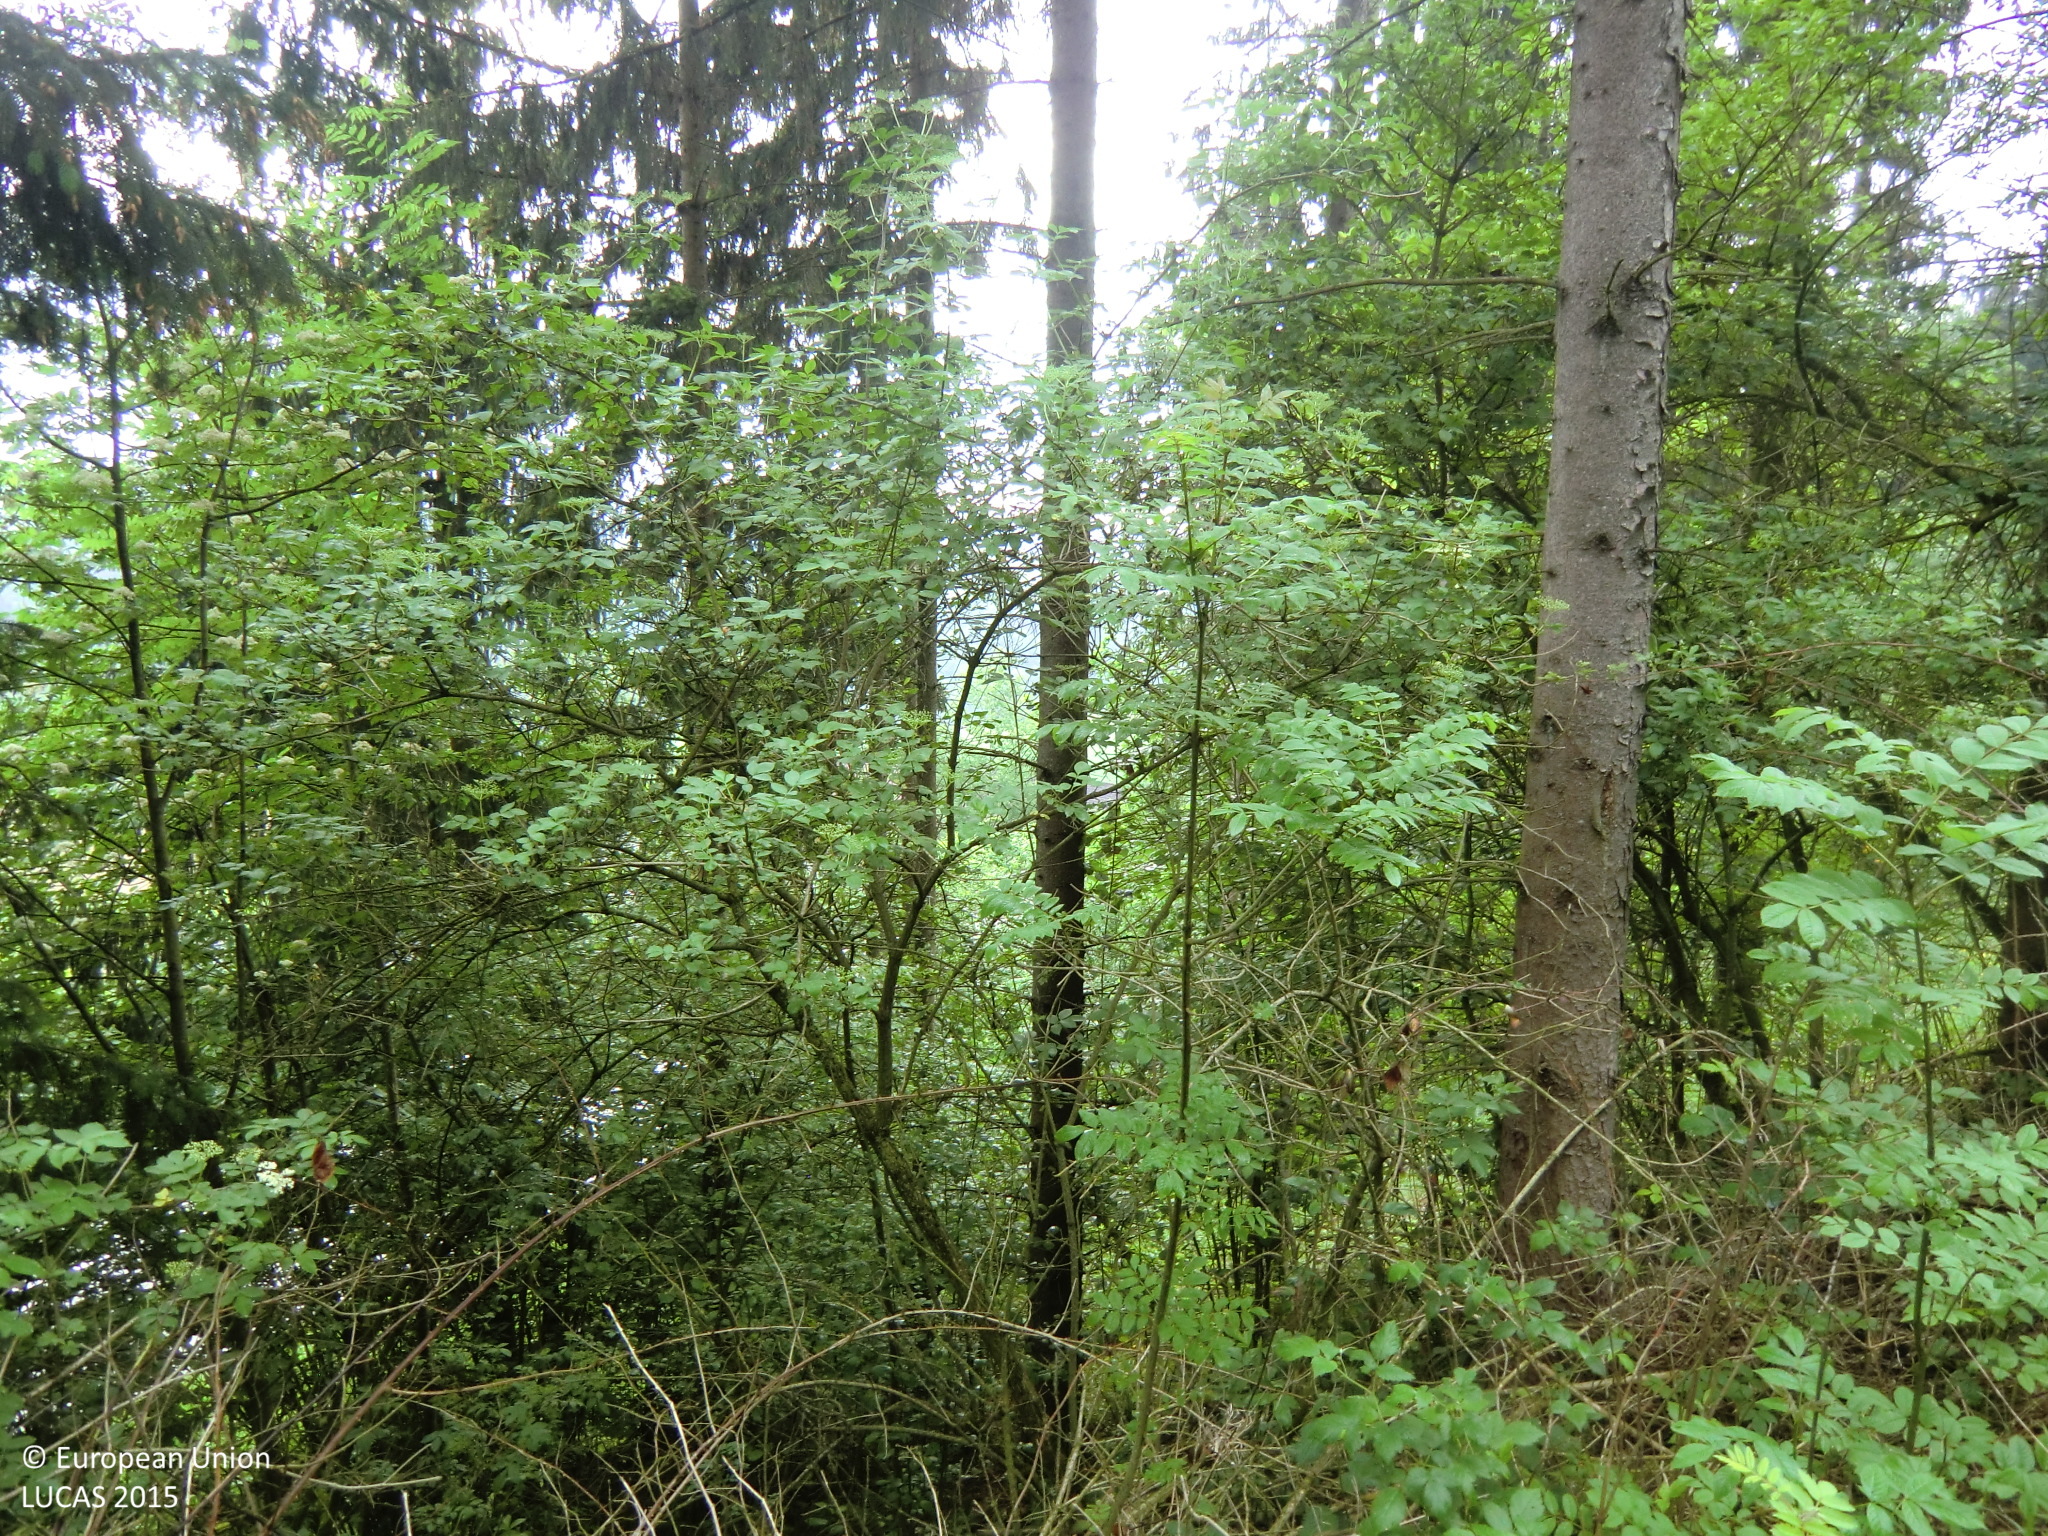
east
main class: Woodland
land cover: Spruce dominated mixed woodland
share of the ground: > 75 %
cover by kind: coniferous forest trees 60 %, broadleaved forest trees 20 %, shrubs 10 %, consolidated bare surface 10 %
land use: Forestry
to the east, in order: Spruce dominated mixed woodland; Grass margins; Paved roads, cycling and walking lanes; Grass margins; Broadleaved woodland; Grass margins; Paved roads, cycling and walking lanes; Grassland without tree/shrub cover; Artificial constructions in urban areas; Grassland without tree/shrub cover; Common wheat
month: May
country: AT
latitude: 48.3460
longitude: 14.5477
